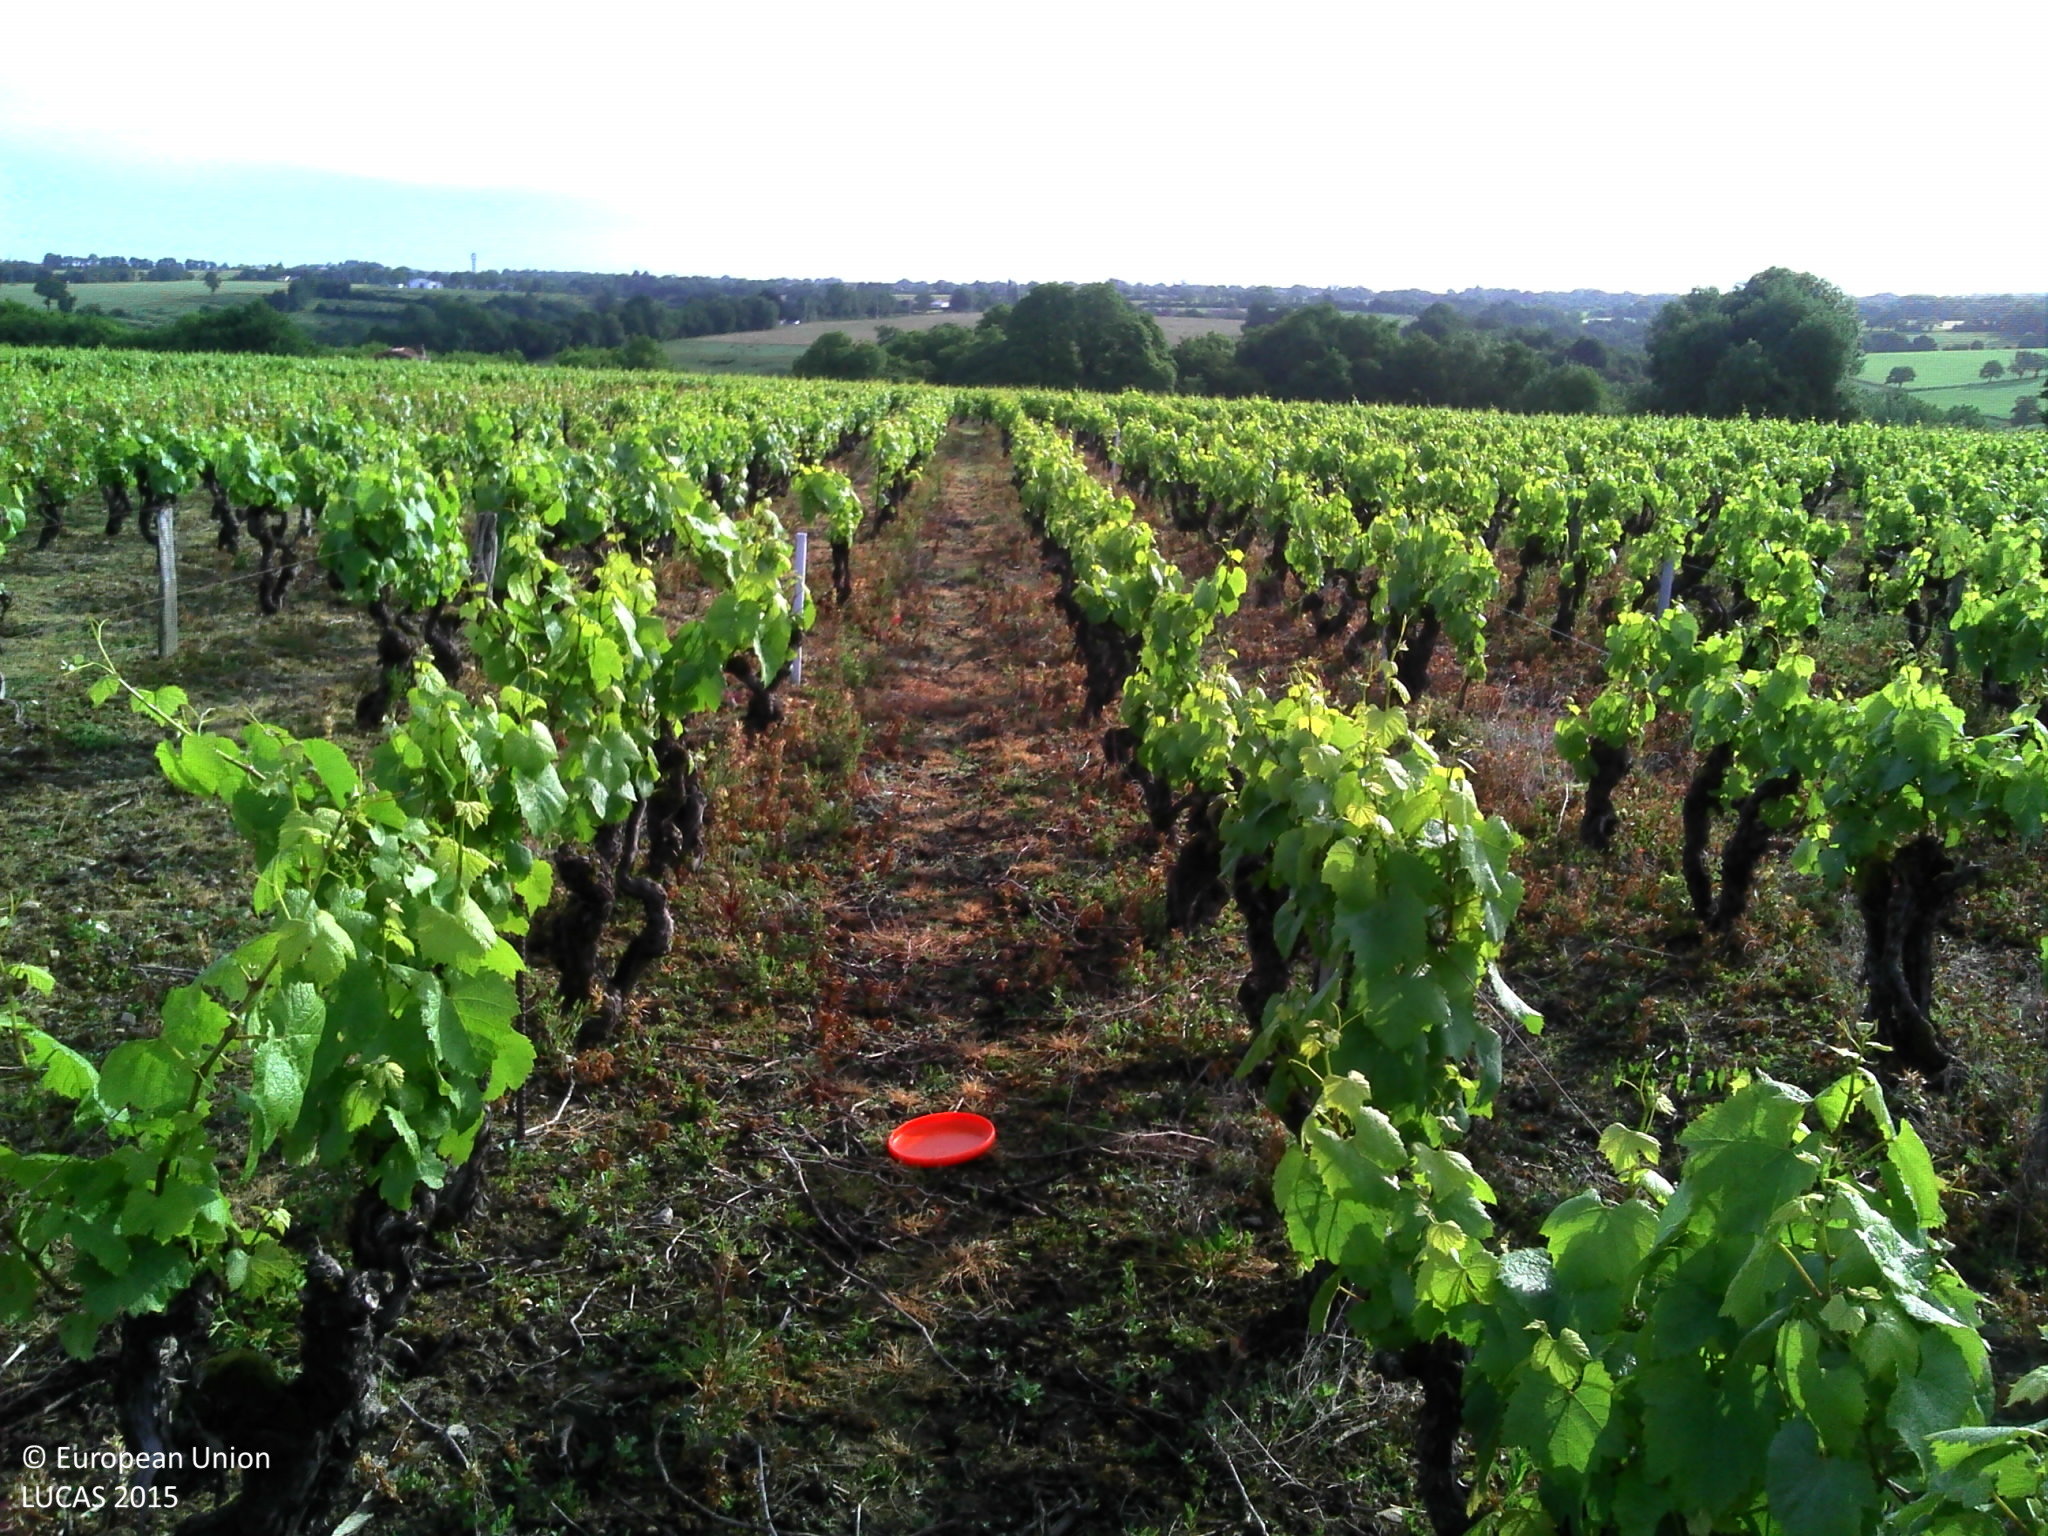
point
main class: Cropland
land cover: Vineyards
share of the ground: > 75 %
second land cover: Spontaneously vegetated surfaces
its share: 25 - 50 %
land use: Agriculture (excluding fallow land and kitchen gardens)
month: June
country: FR
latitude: 47.2960
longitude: -1.2930
